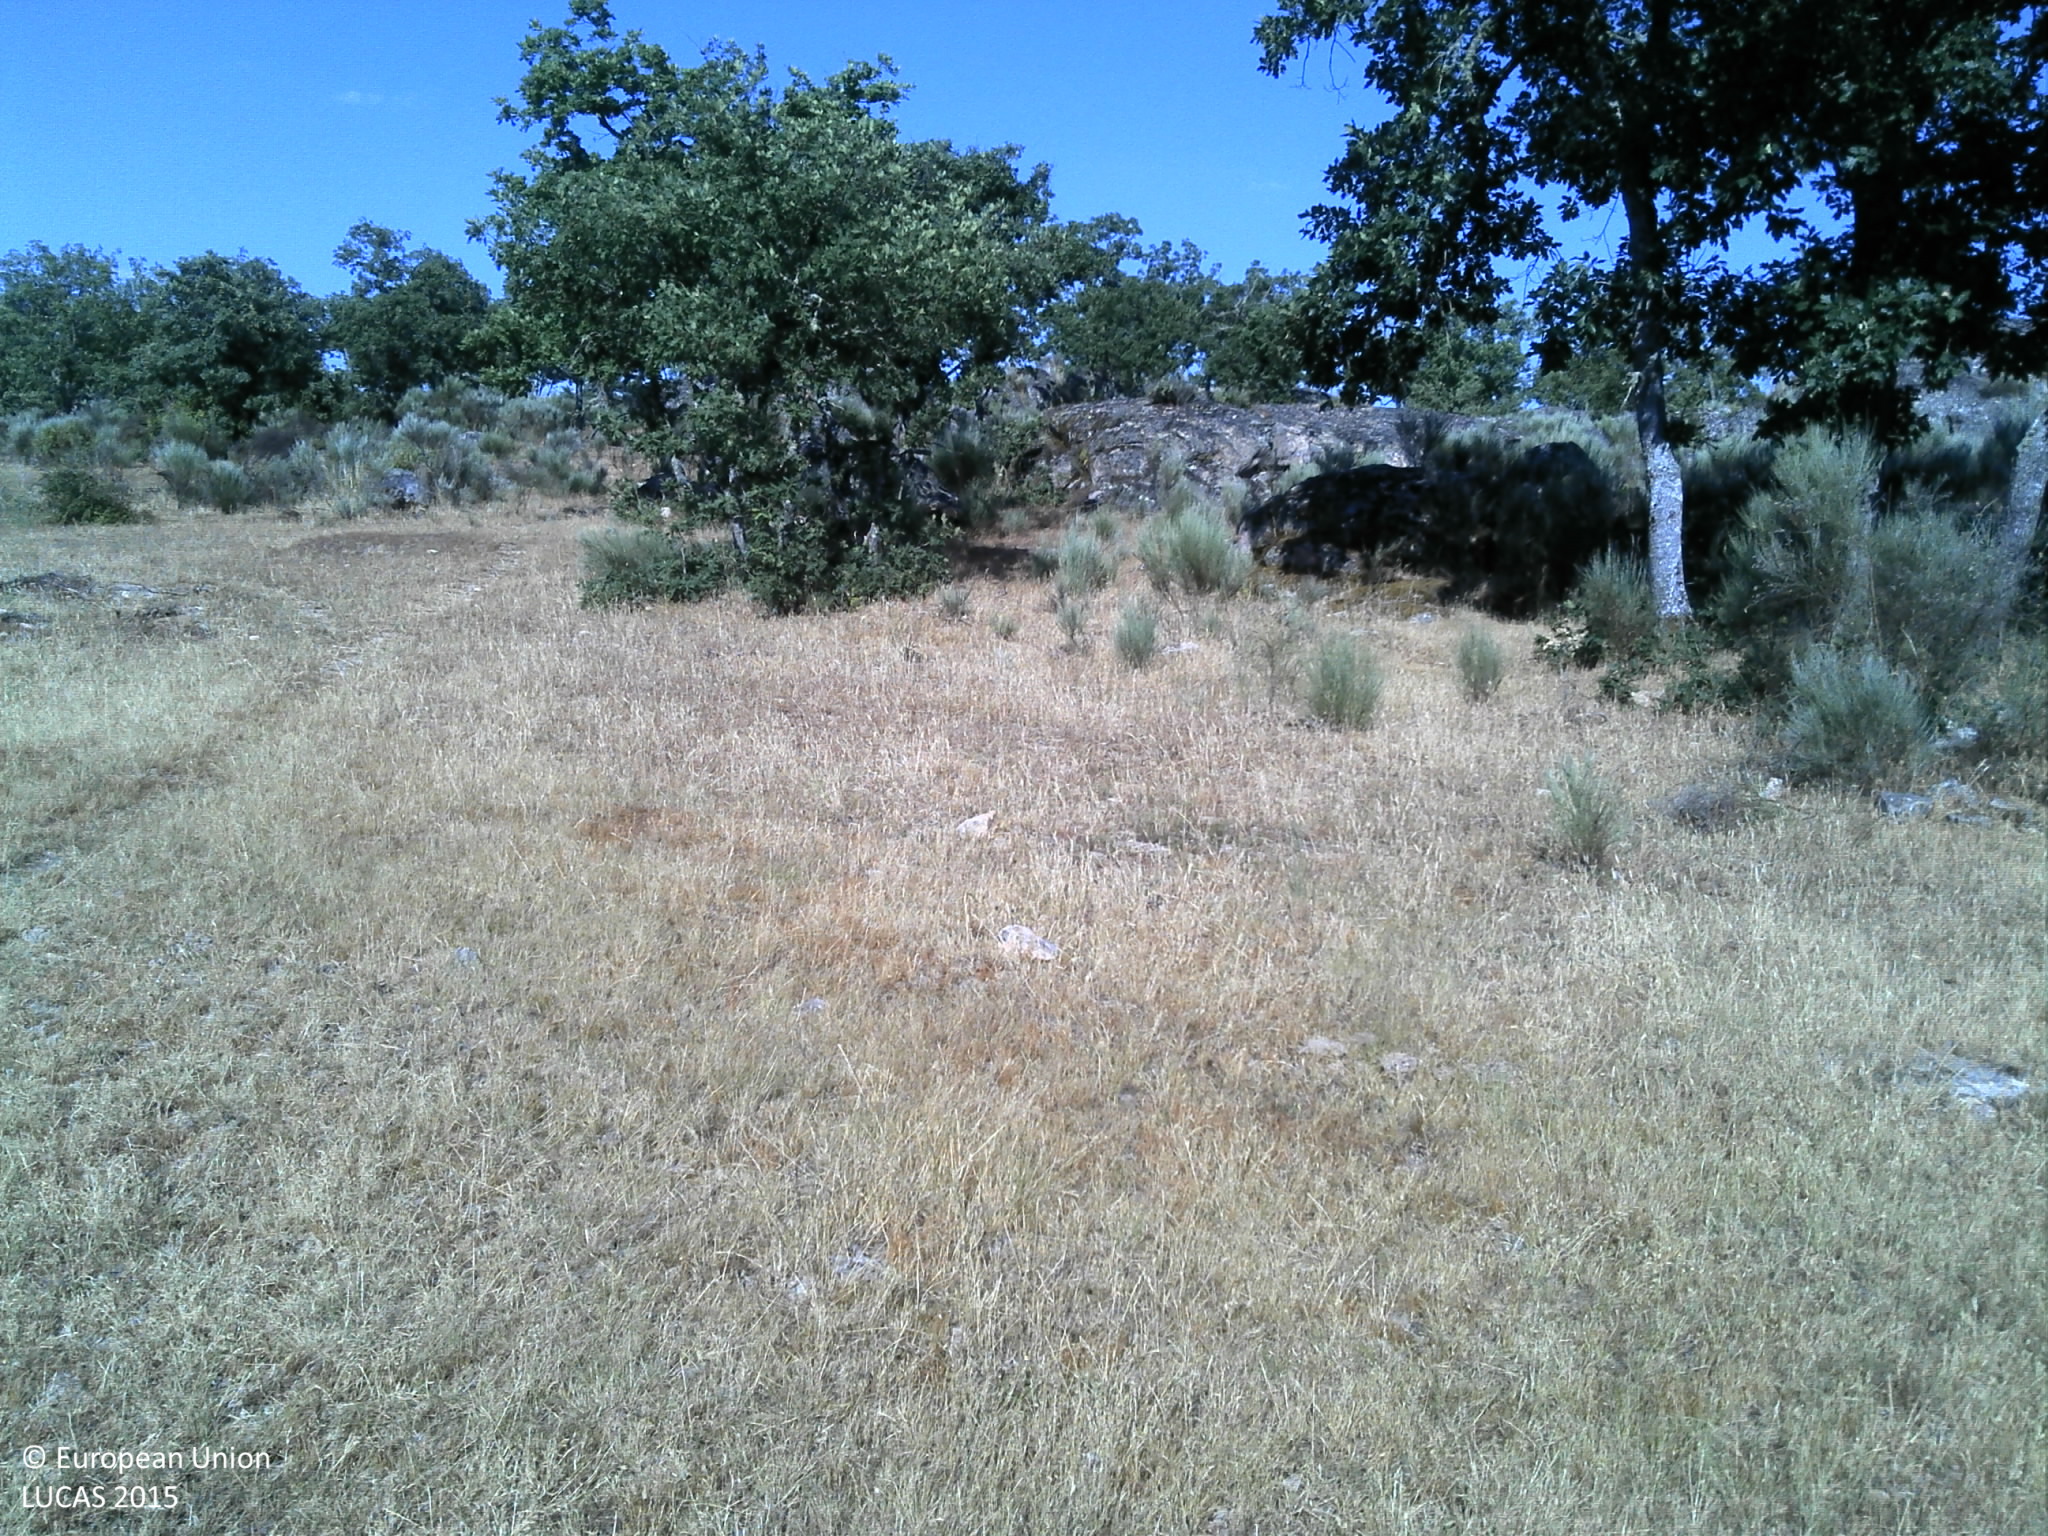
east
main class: Grassland
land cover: Grassland without tree/shrub cover
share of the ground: > 75 %
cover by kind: herbaceous plants 90 %, unconsolidated bare surface 10 %
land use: Agriculture (excluding fallow land and kitchen gardens)
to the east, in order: Grassland without tree/shrub cover; Grassland with sparse tree/shrub cover; Rocks and stones; Grassland with sparse tree/shrub cover; Rocks and stones; Grassland with sparse tree/shrub cover; Rock outcrops; Grassland with sparse tree/shrub cover
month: June
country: PT
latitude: 40.7893
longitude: -6.8451
